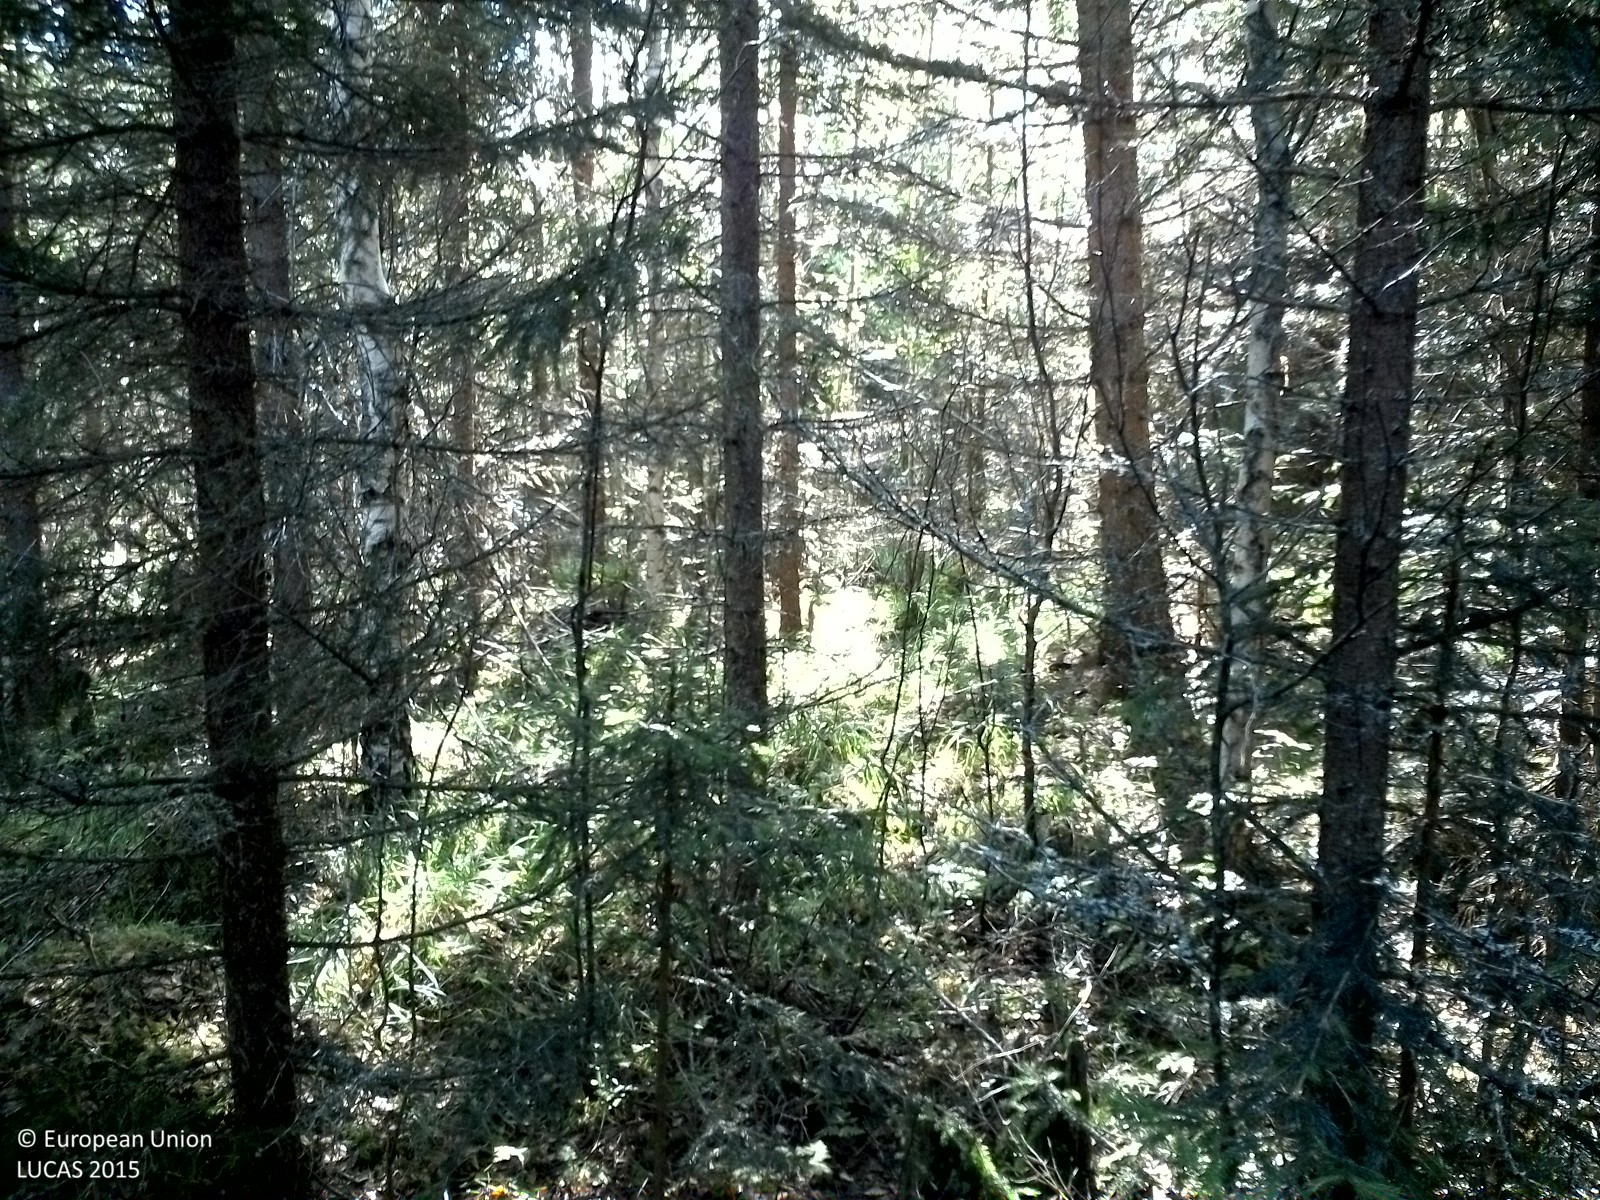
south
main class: Woodland
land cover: Spruce dominated mixed woodland
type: boreal forest
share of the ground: > 75 %
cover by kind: coniferous forest trees 45 %, broadleaved forest trees 25 %, herbaceous plants 15 %, lichens and mosses 15 %
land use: Forestry
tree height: > 5 m
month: September
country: SE
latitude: 62.5334
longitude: 16.3340
